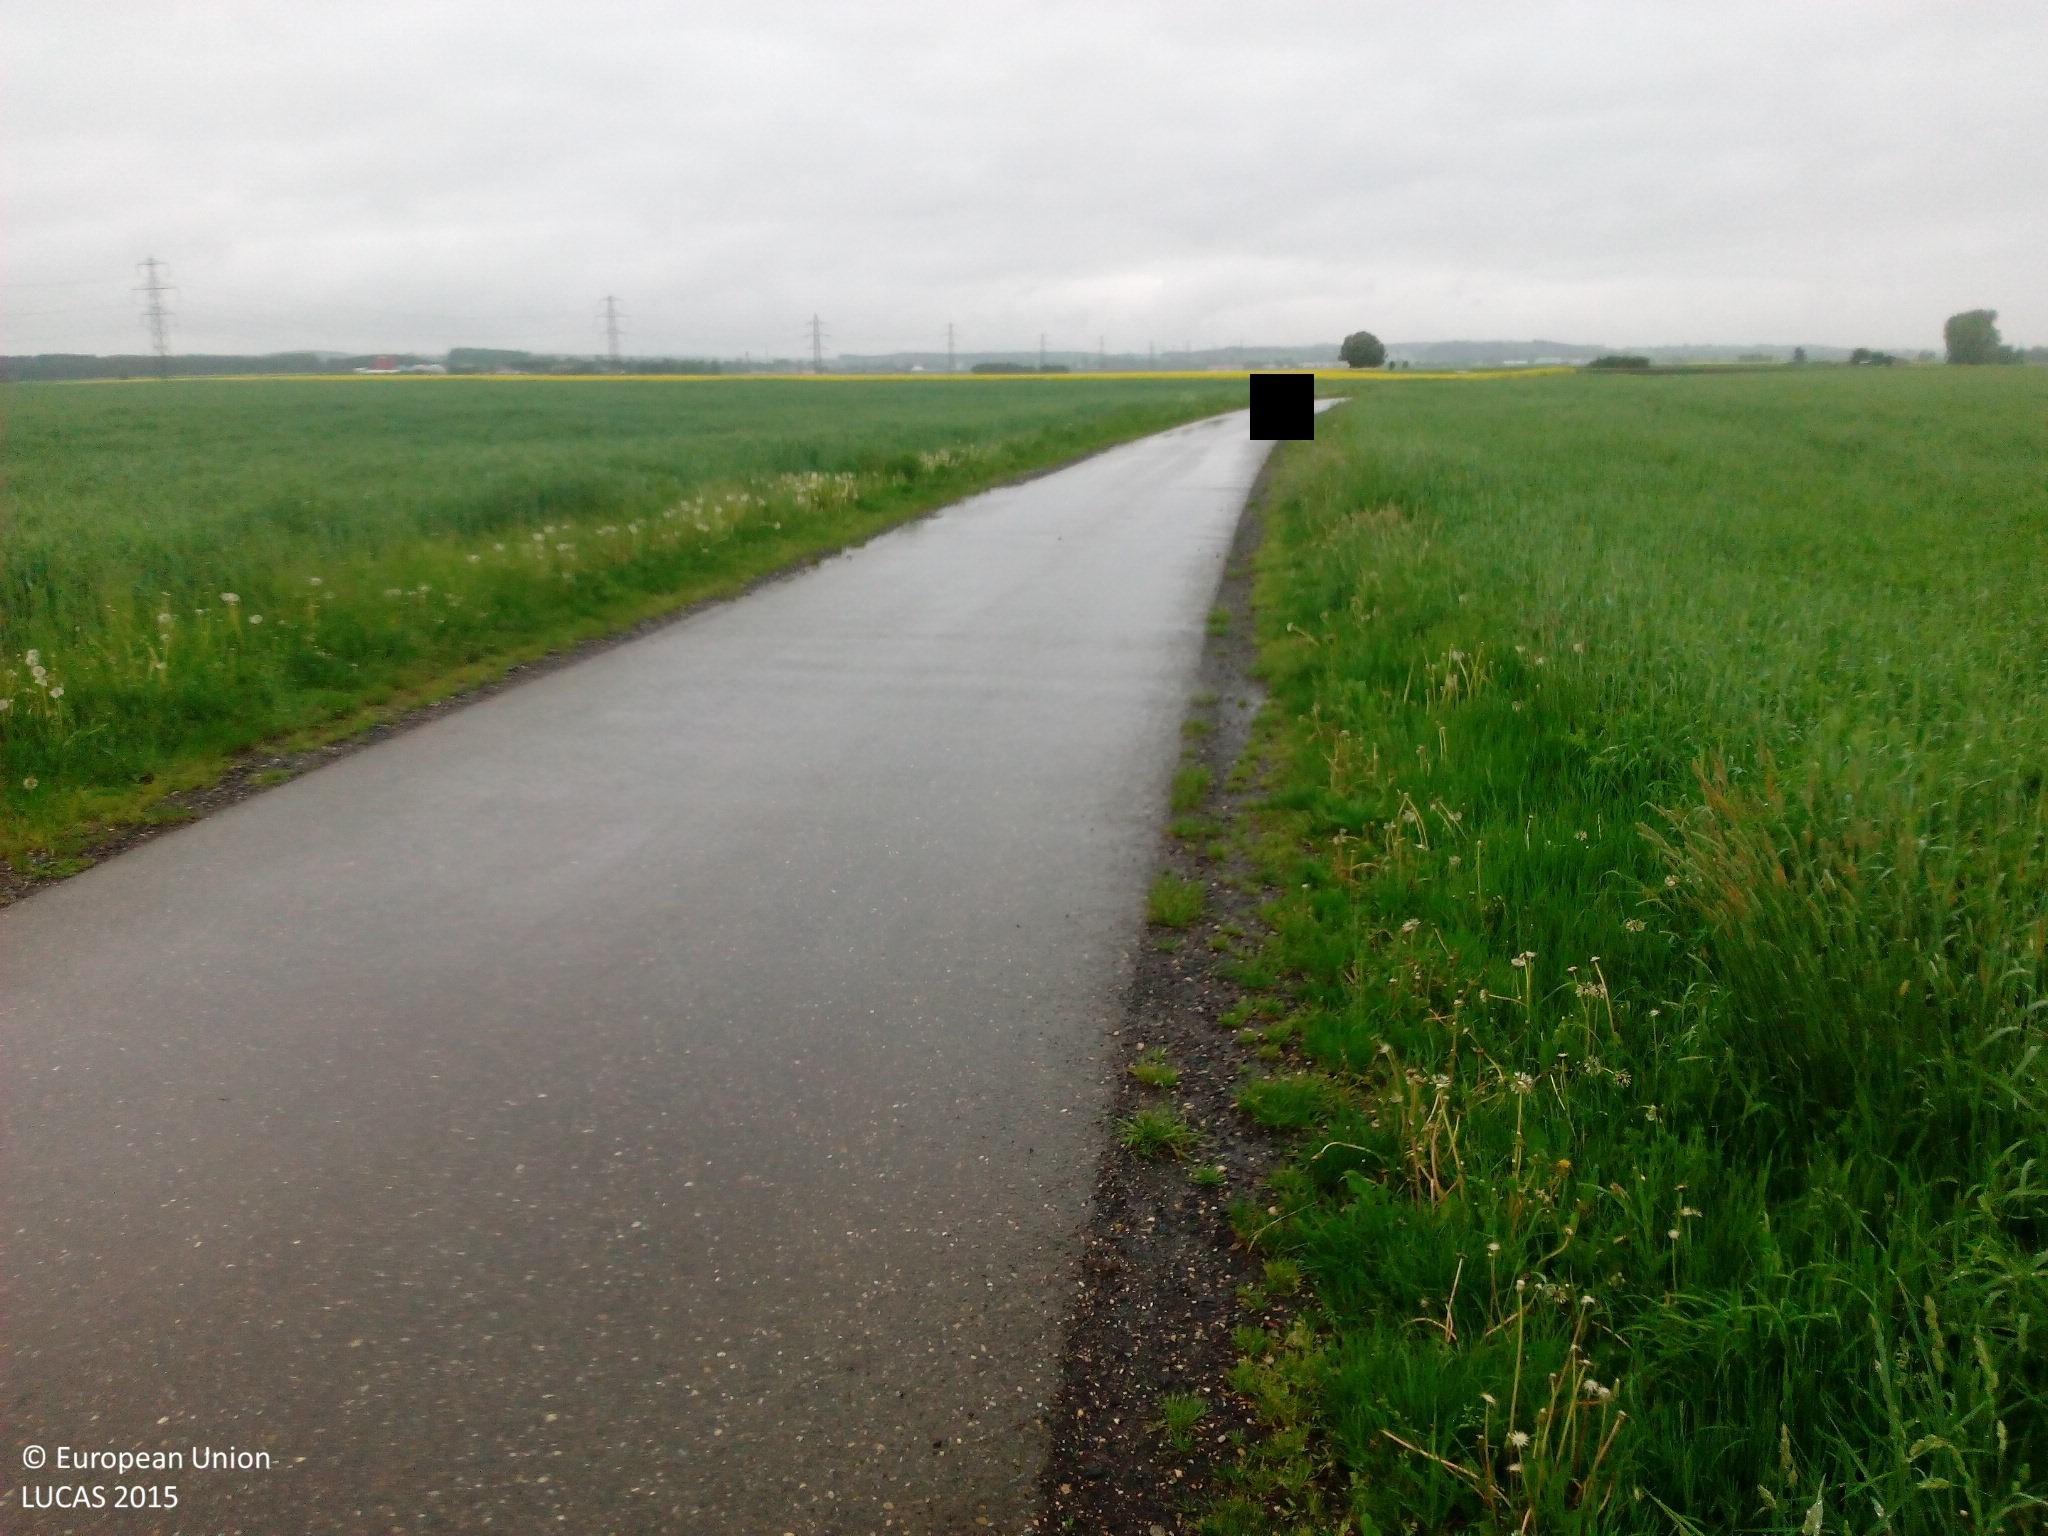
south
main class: Cropland
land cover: Rye
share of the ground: > 75 %
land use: Agriculture (excluding fallow land and kitchen gardens)
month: May
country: DE
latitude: 48.0960
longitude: 9.4230
